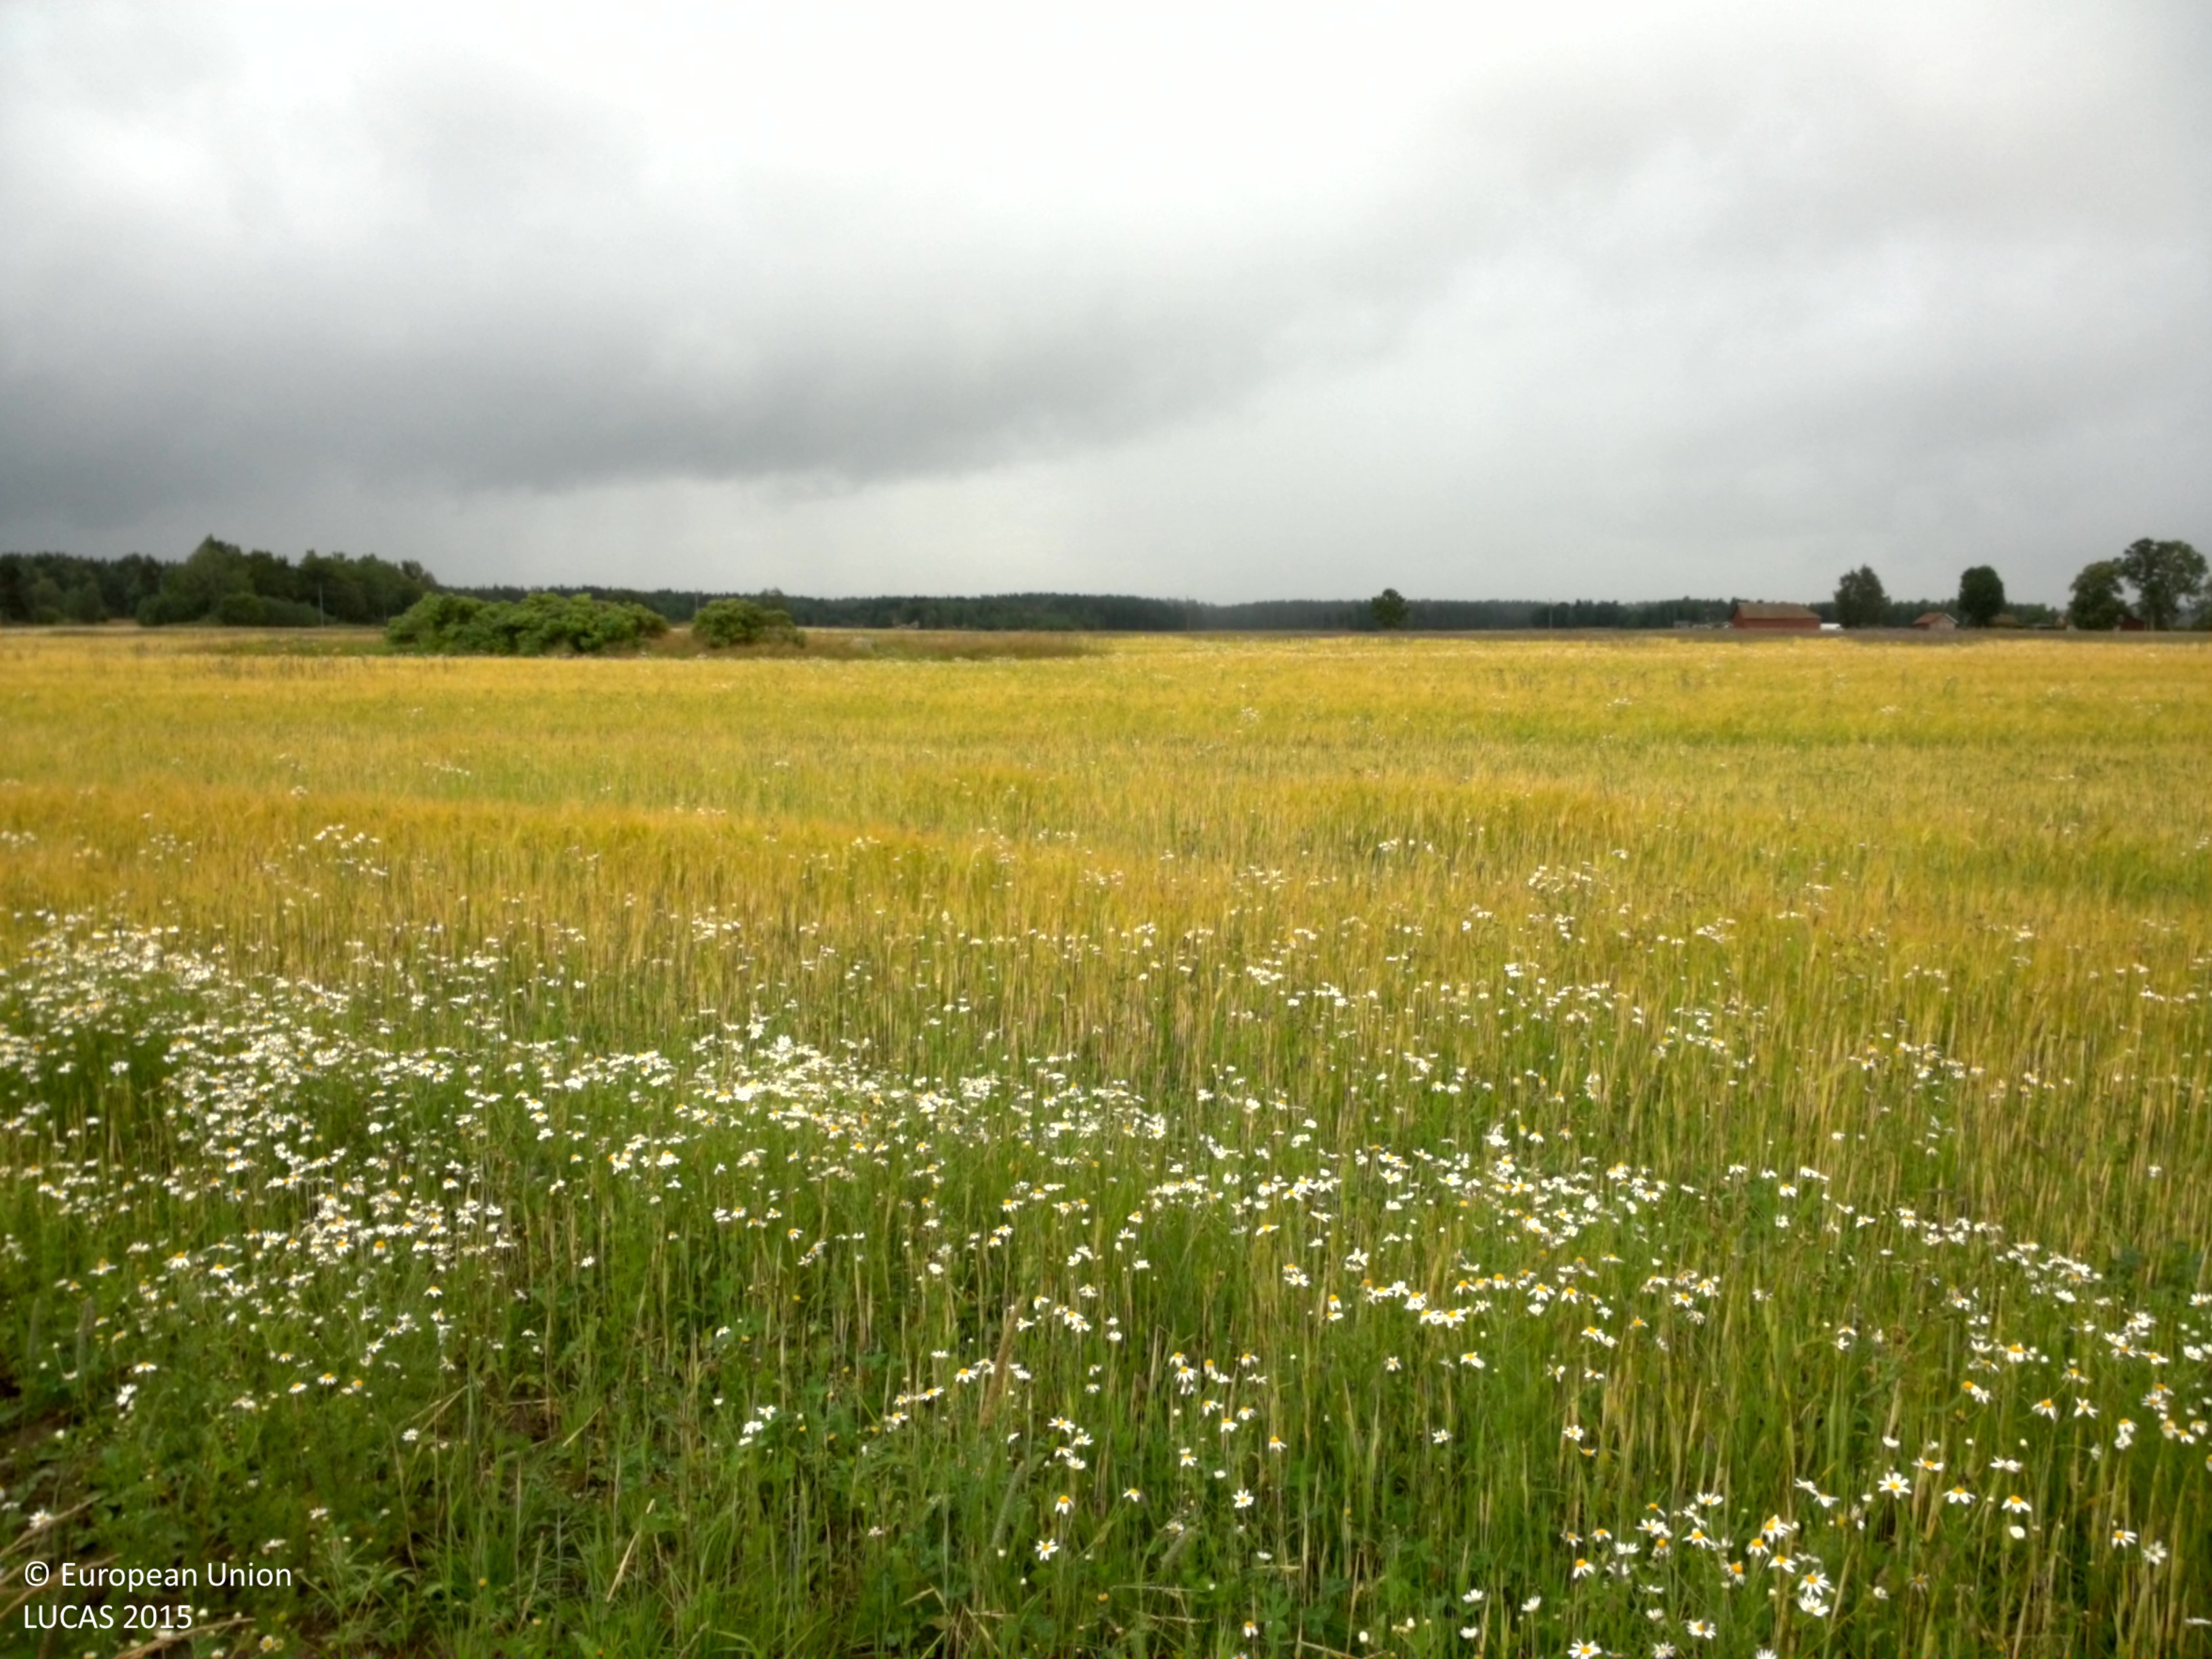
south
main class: Cropland
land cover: Barley
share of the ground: 25 - 50 %
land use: Agriculture (excluding fallow land and kitchen gardens)
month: July
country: SE
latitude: 58.7379
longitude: 13.9493
